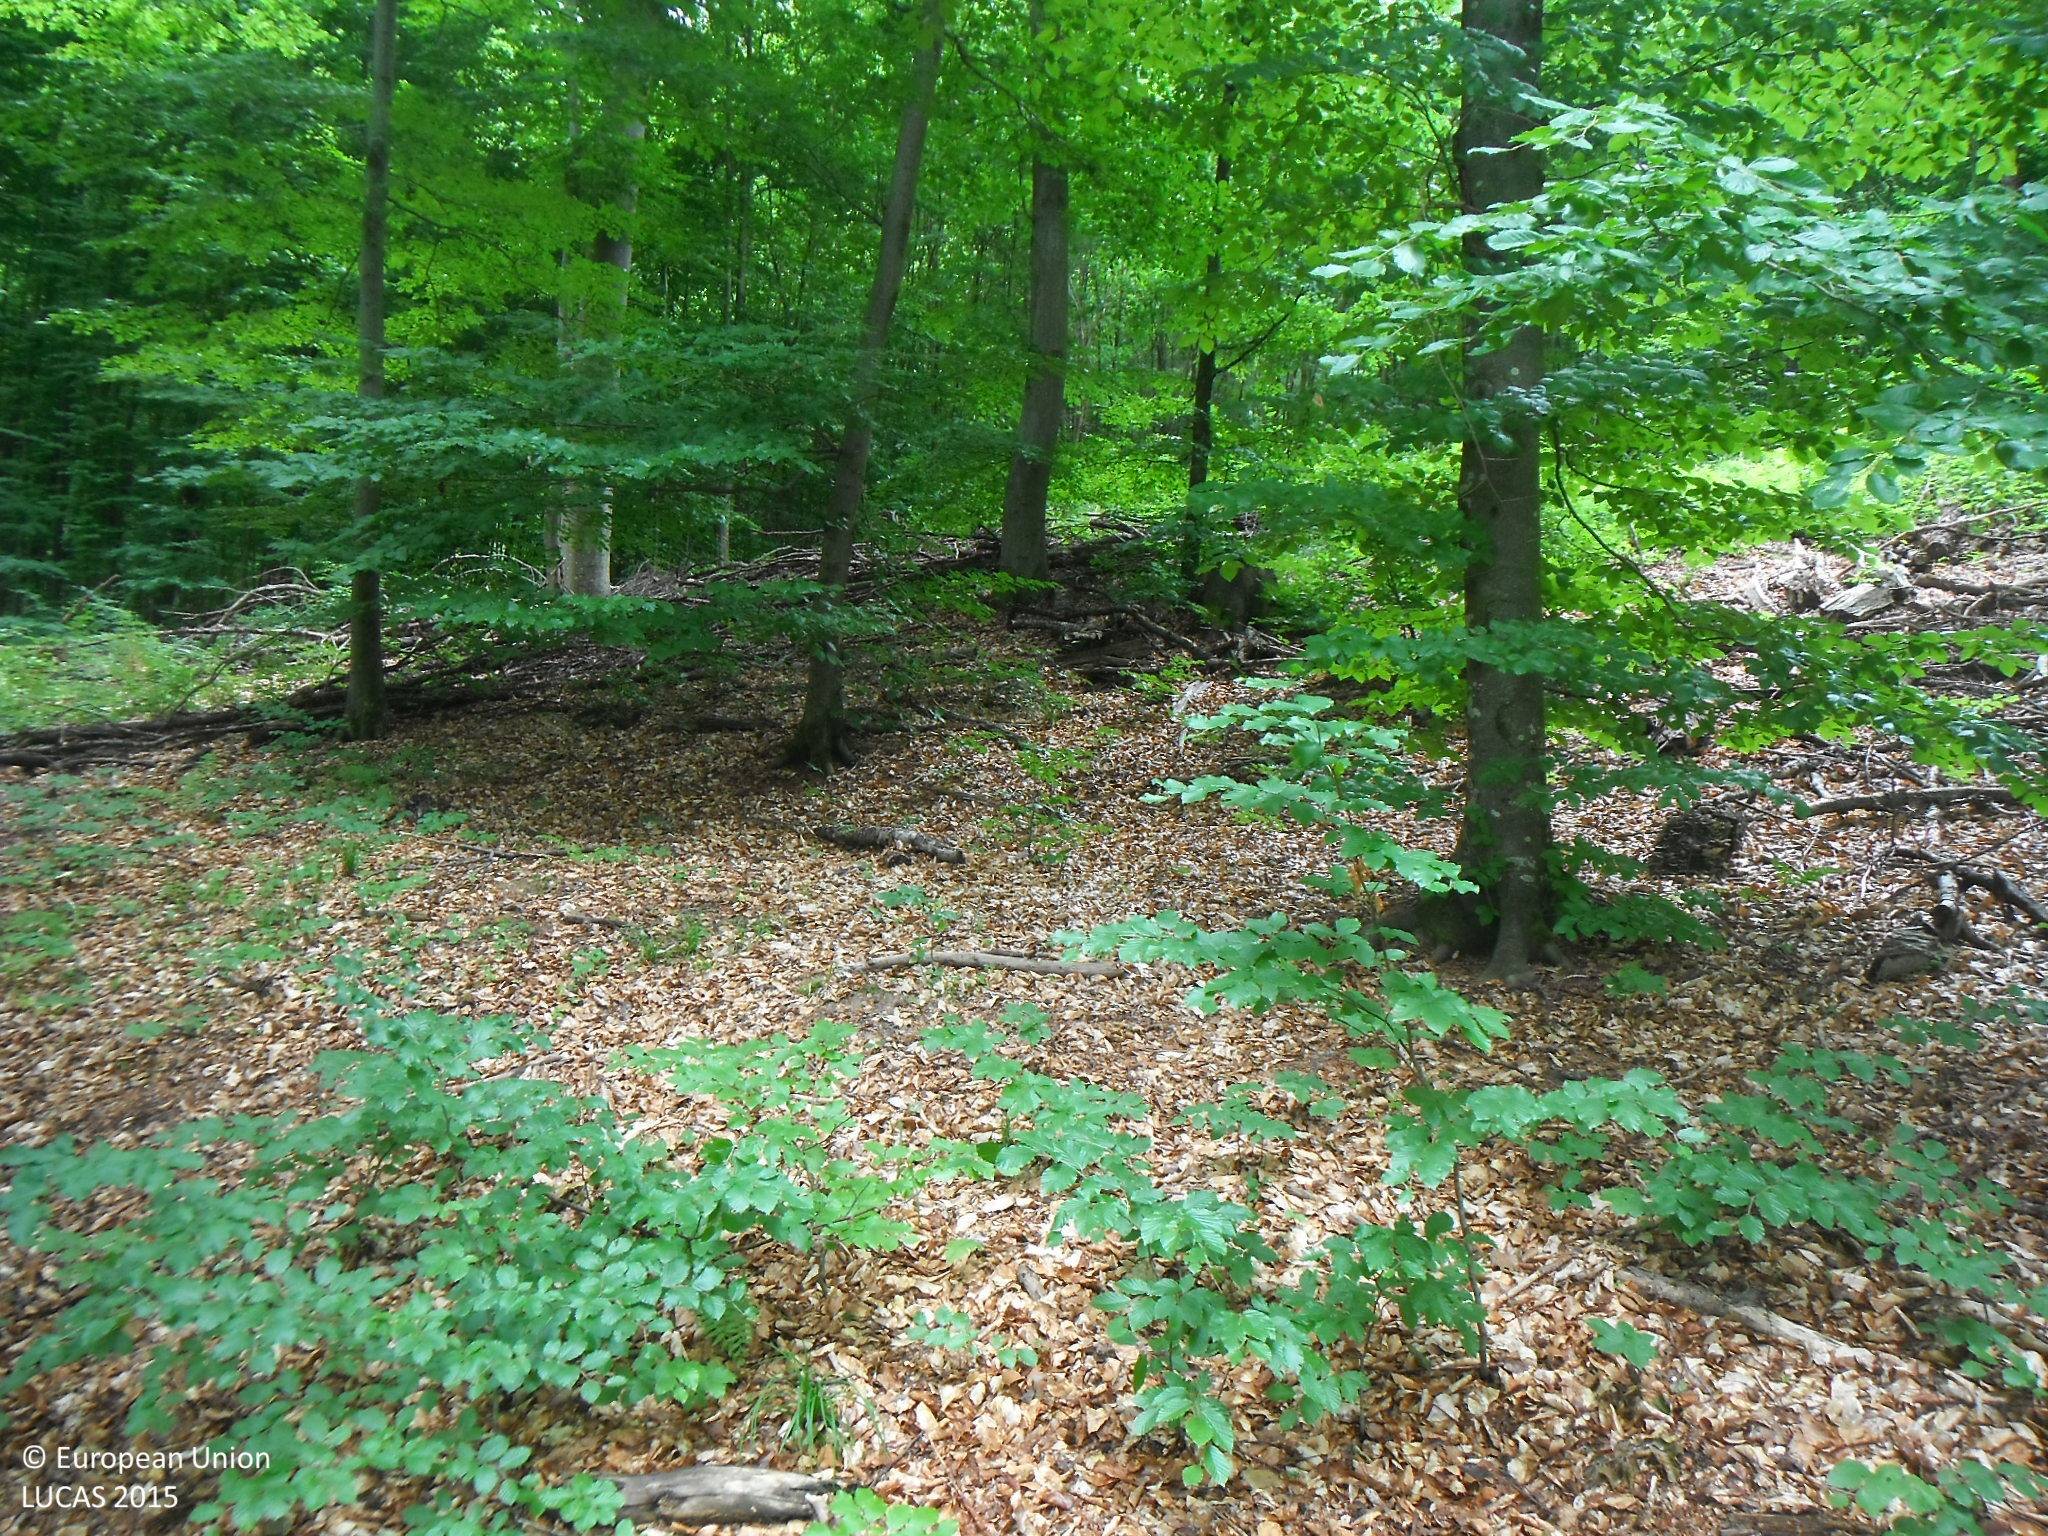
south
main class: Woodland
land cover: Broadleaved woodland
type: beech forest
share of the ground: > 75 %
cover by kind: broadleaved forest trees 80 %, herbaceous plants 15 %, lichens and mosses 5 %
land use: Forestry
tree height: > 5 m
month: June
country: SK
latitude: 49.0565
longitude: 22.0021
